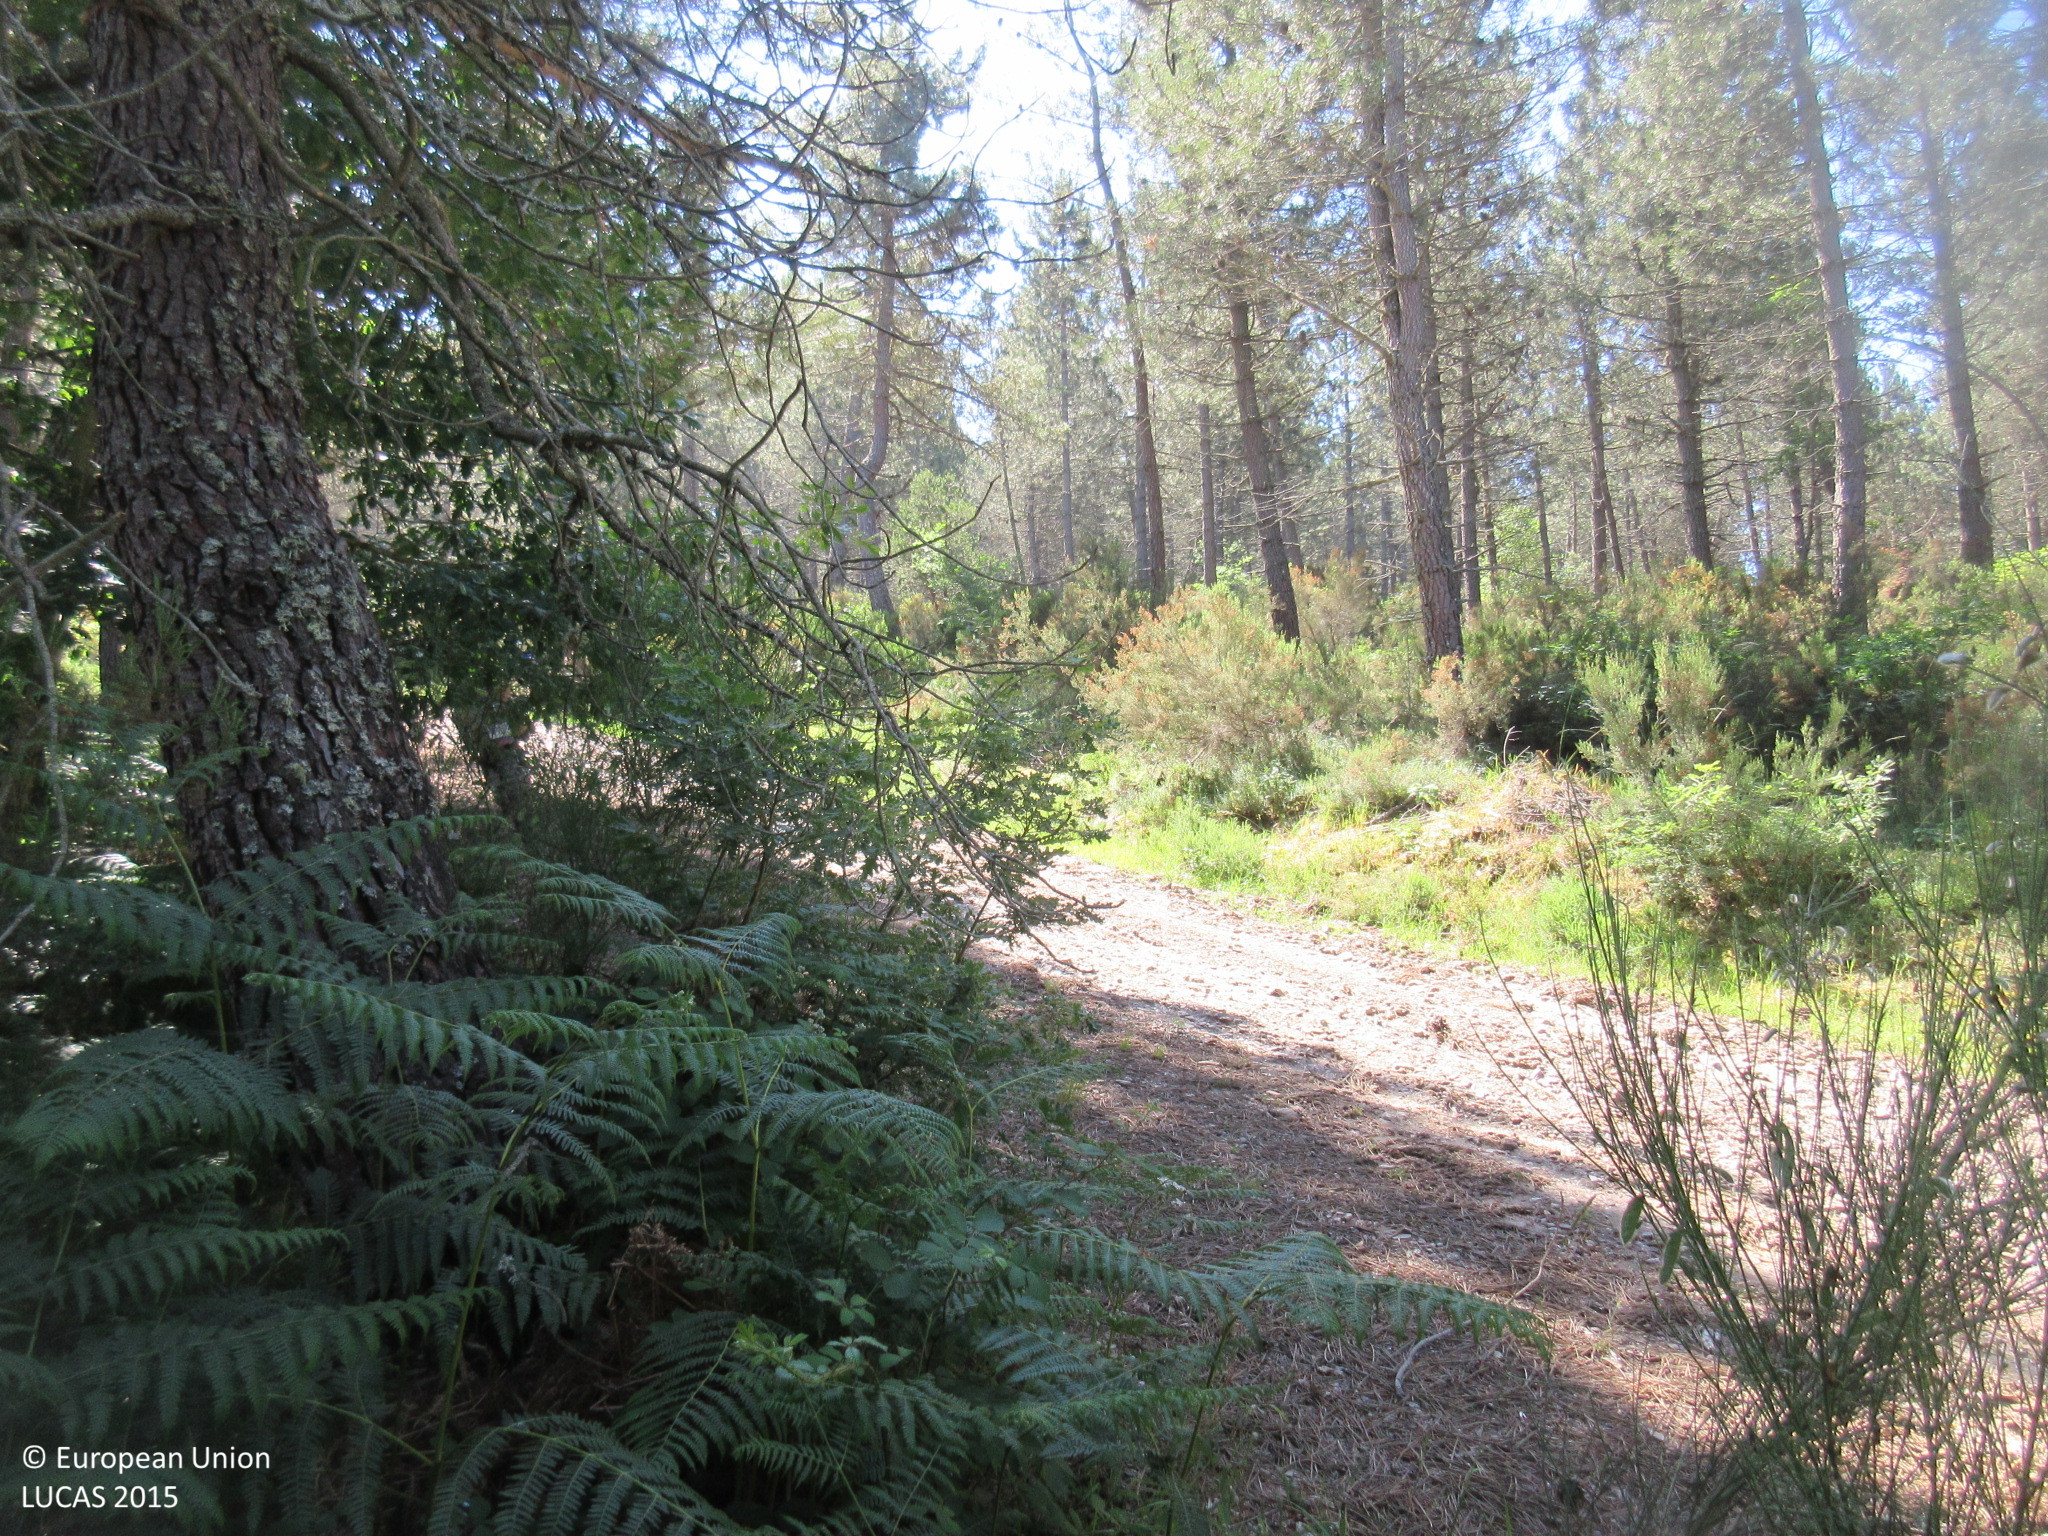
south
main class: Woodland
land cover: Pine dominated coniferous woodland
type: hemiboreal forest and nemoral coniferous forest and mixed broadleaved-coniferous forest
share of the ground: > 75 %
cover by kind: coniferous forest trees 95 %, shrubs 5 %
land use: Forestry
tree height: > 5 m
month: June
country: ES
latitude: 42.9244
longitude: -6.9552
